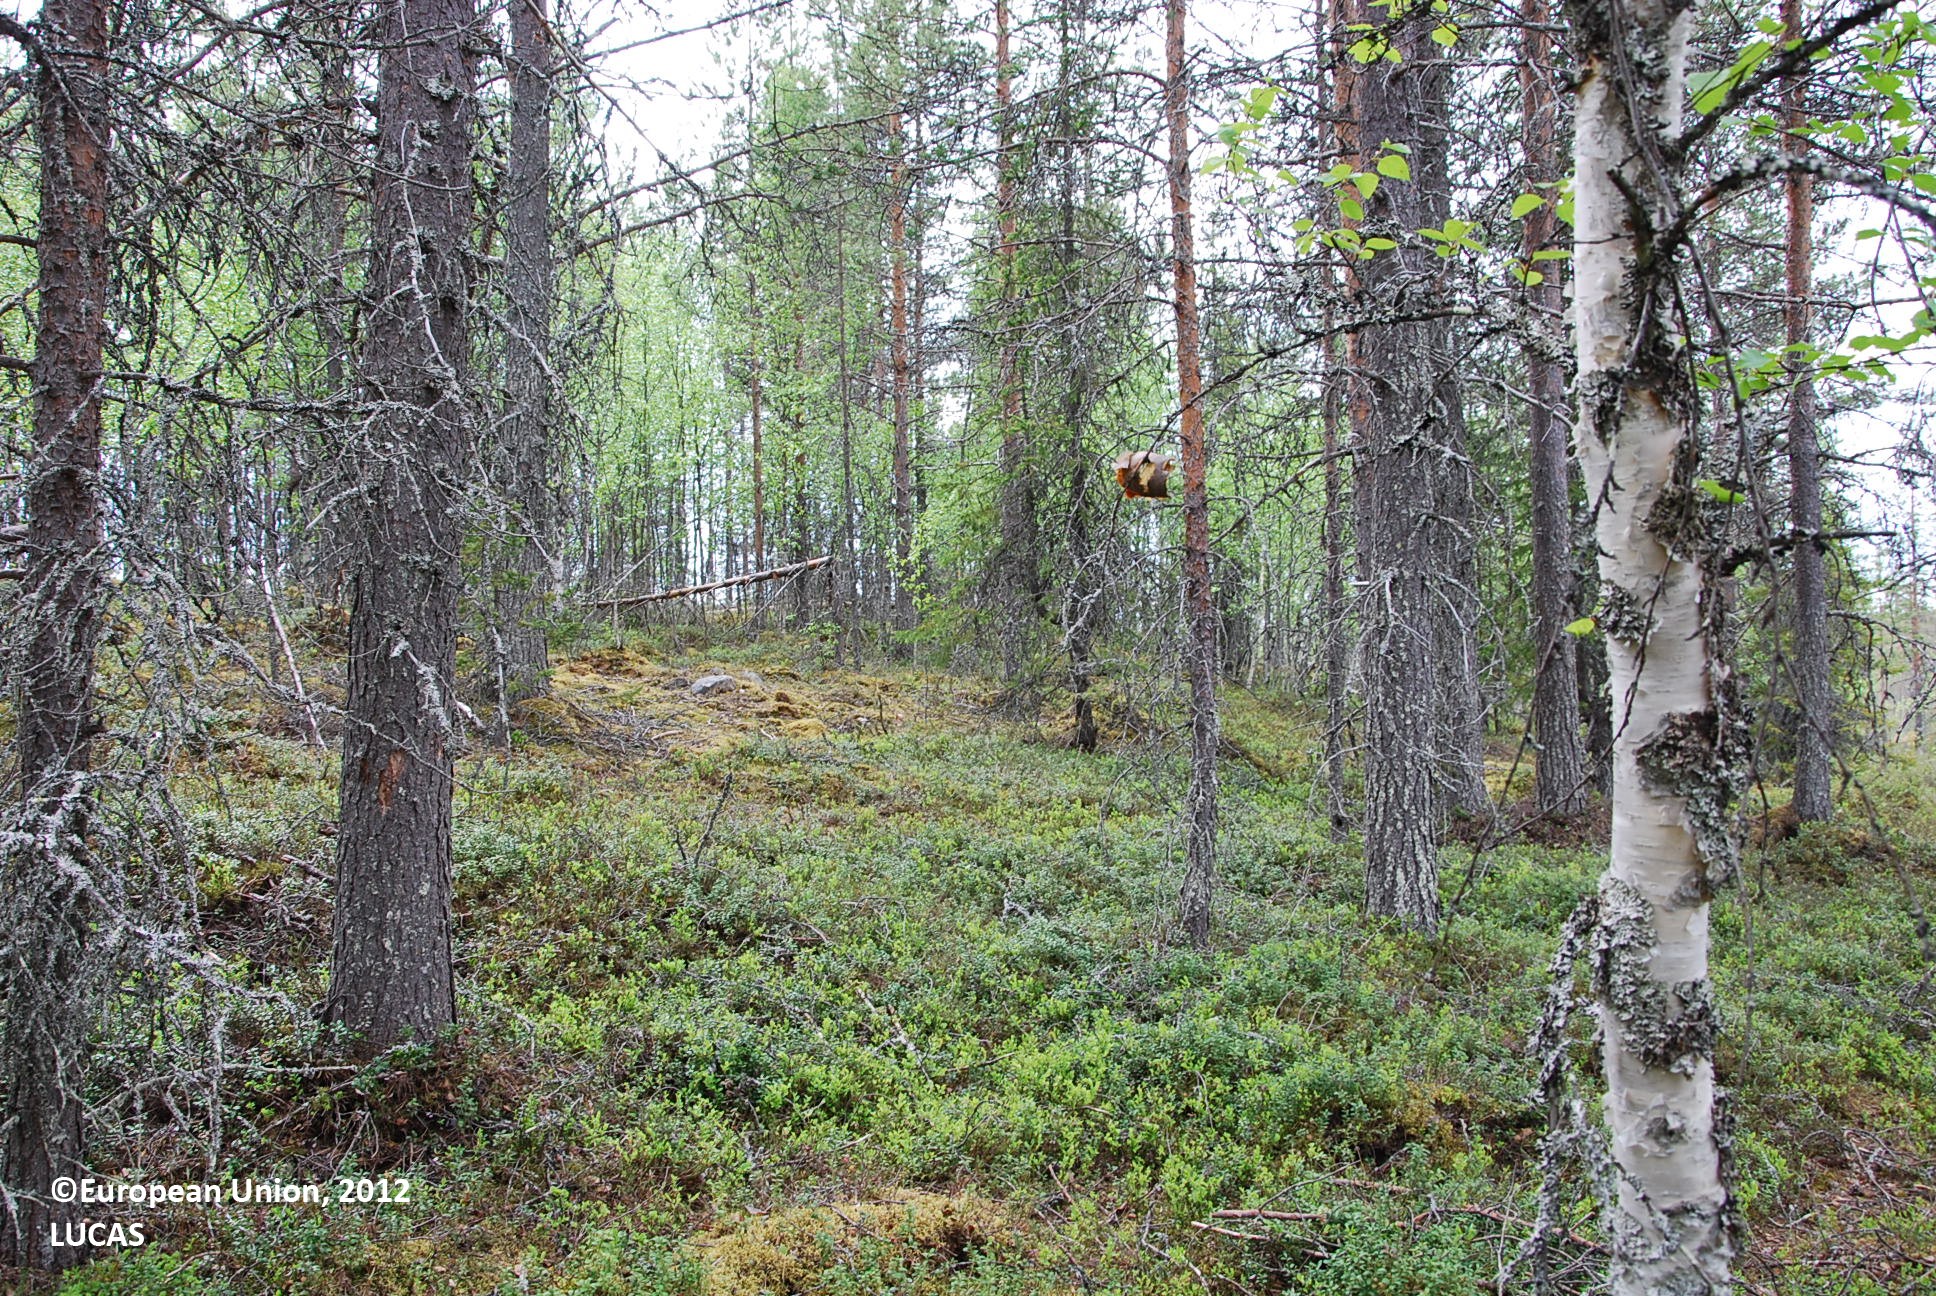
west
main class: Woodland
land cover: Pine dominated mixed woodland
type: boreal forest
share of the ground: > 75 %
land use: Forestry
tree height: > 5 m
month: June
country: FI
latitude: 66.0406
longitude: 27.6708
